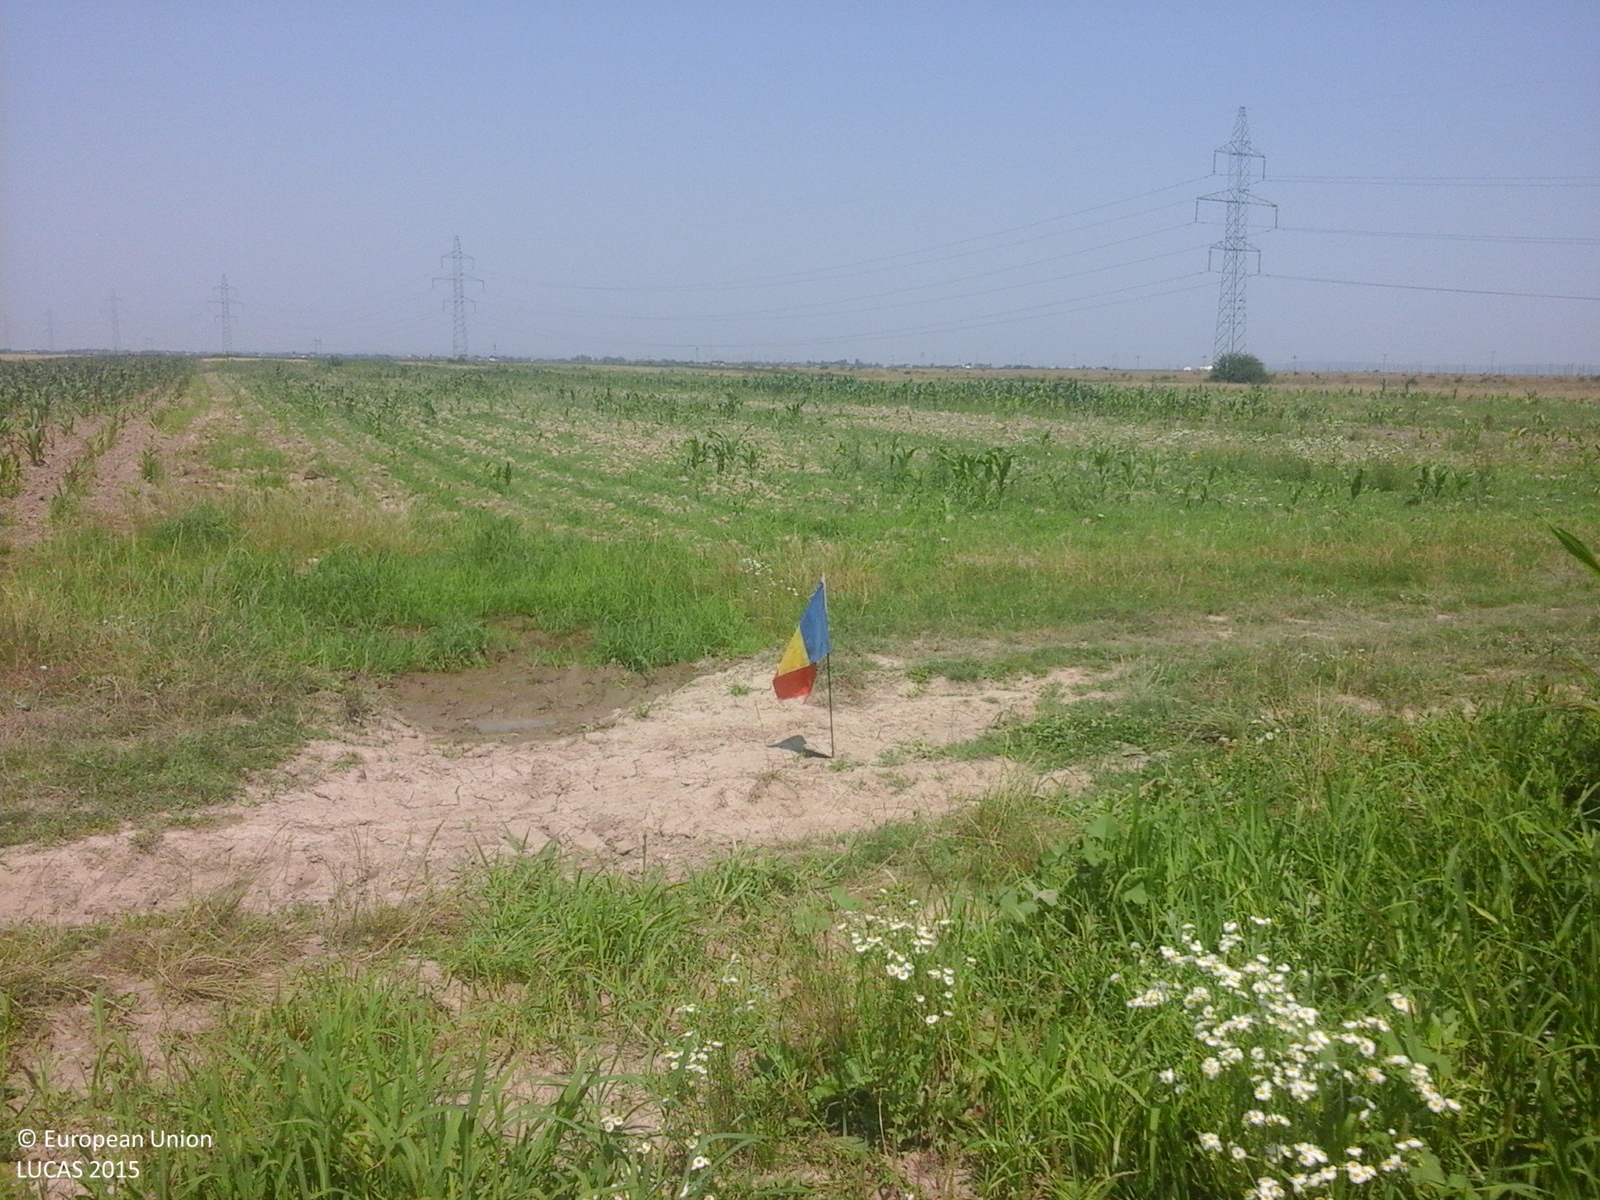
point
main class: Cropland
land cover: Maize
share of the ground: 50 - 75 %
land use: Agriculture (excluding fallow land and kitchen gardens)
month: July
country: RO
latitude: 44.7334
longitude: 25.0219
